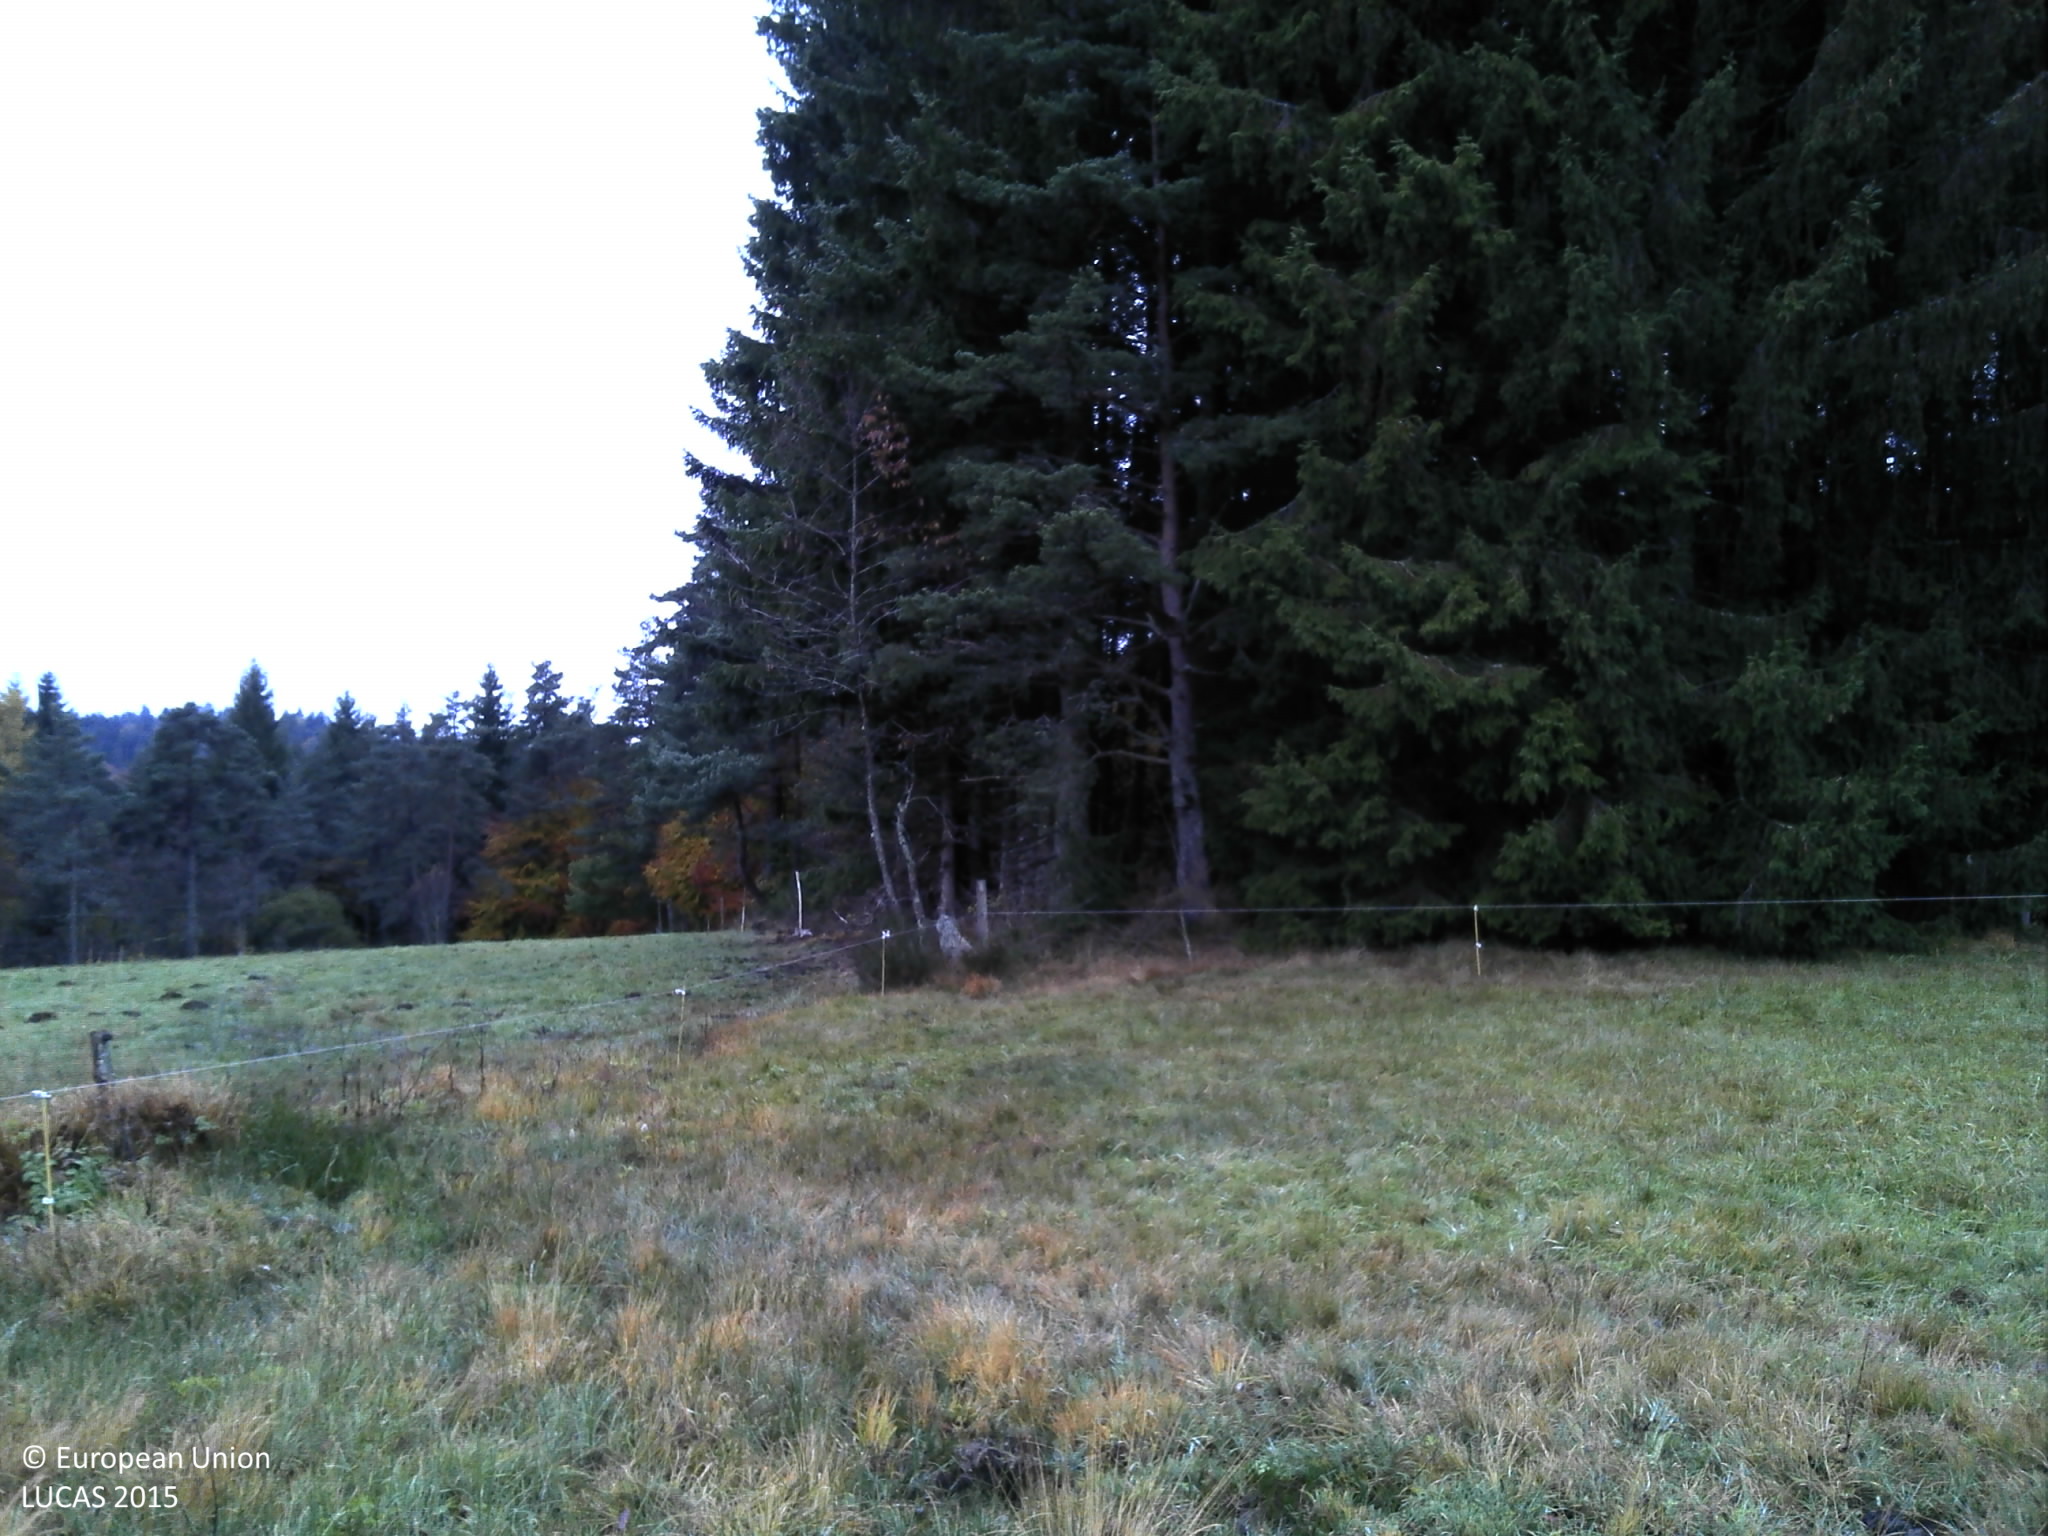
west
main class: Grassland
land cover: Grassland without tree/shrub cover
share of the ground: > 75 %
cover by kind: herbaceous plants 100 %
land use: Agriculture (excluding fallow land and kitchen gardens)
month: October
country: FR
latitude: 45.4143
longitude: 3.8310
